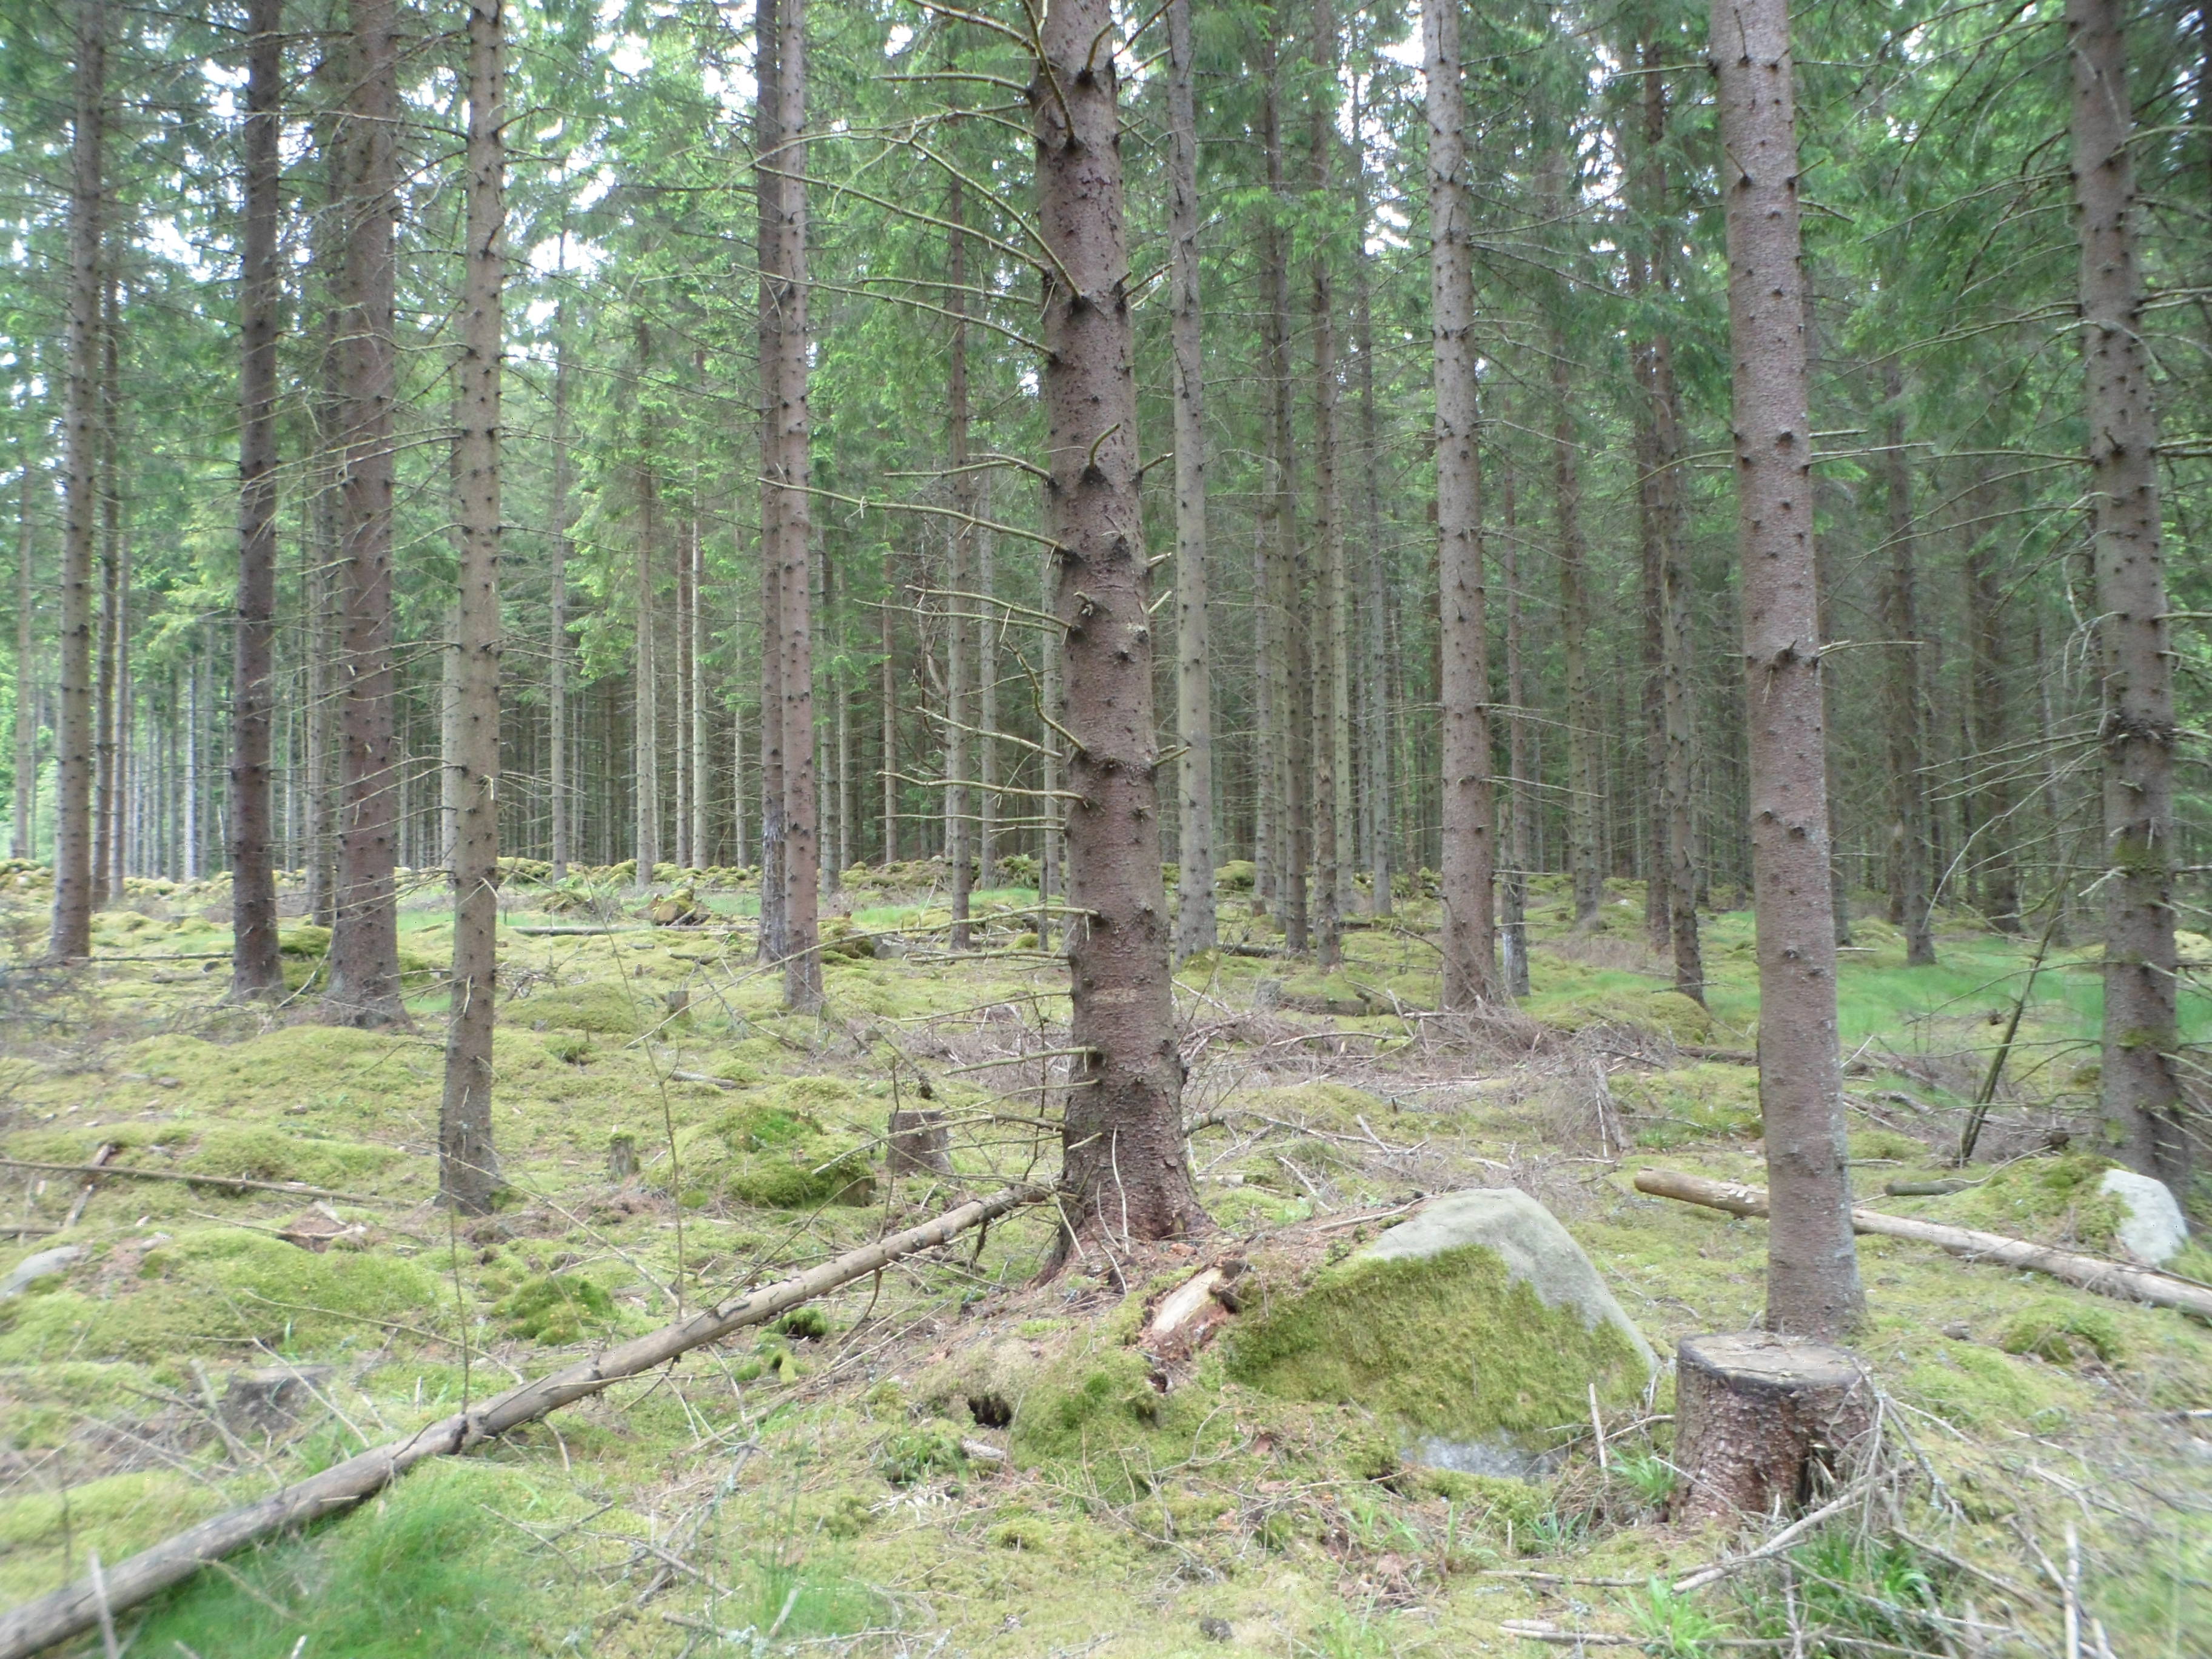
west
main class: Woodland
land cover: Spruce dominated coniferous woodland
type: boreal forest
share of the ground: 50 - 75 %
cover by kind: coniferous forest trees 60 %, lichens and mosses 25 %, herbaceous plants 15 %
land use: Forestry
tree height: > 5 m
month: June
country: SE
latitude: 56.8123
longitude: 14.4687
